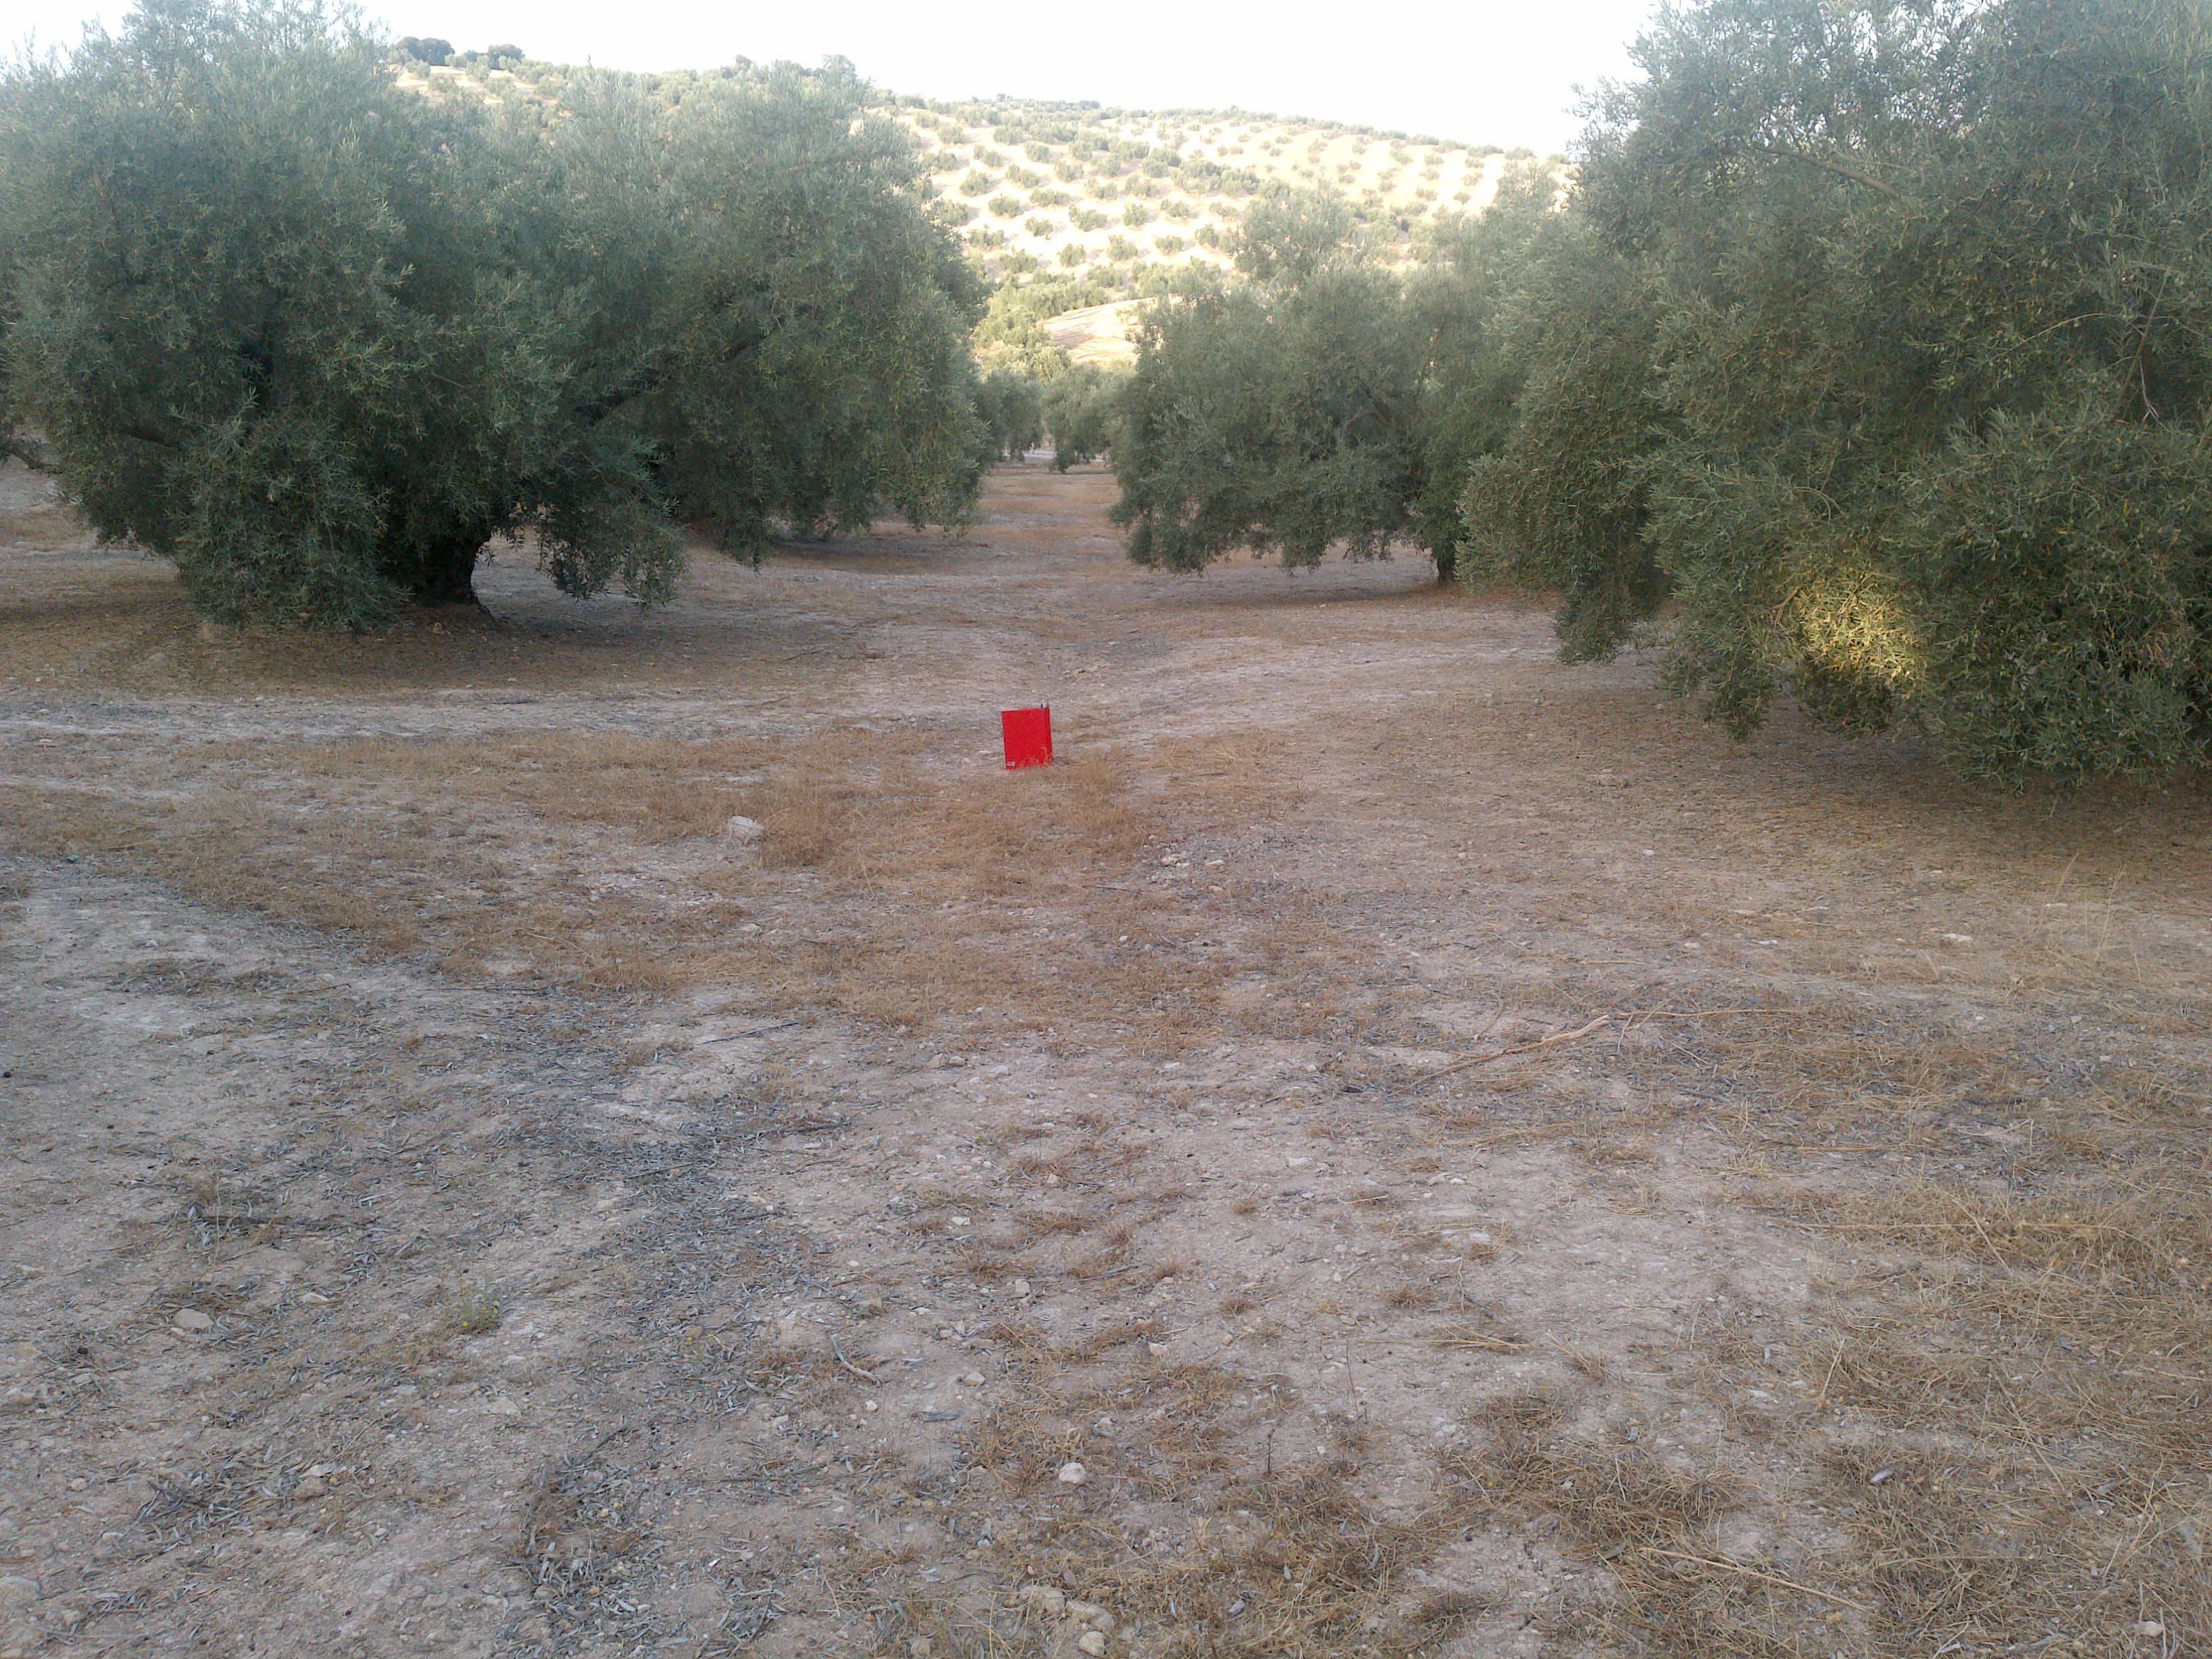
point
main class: Cropland
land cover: Olive groves
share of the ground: 50 - 75 %
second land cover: Spontaneously vegetated surfaces
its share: 10 - 25 %
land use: Agriculture (excluding fallow land and kitchen gardens)
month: July
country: ES
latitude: 37.3807
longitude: -4.4004
